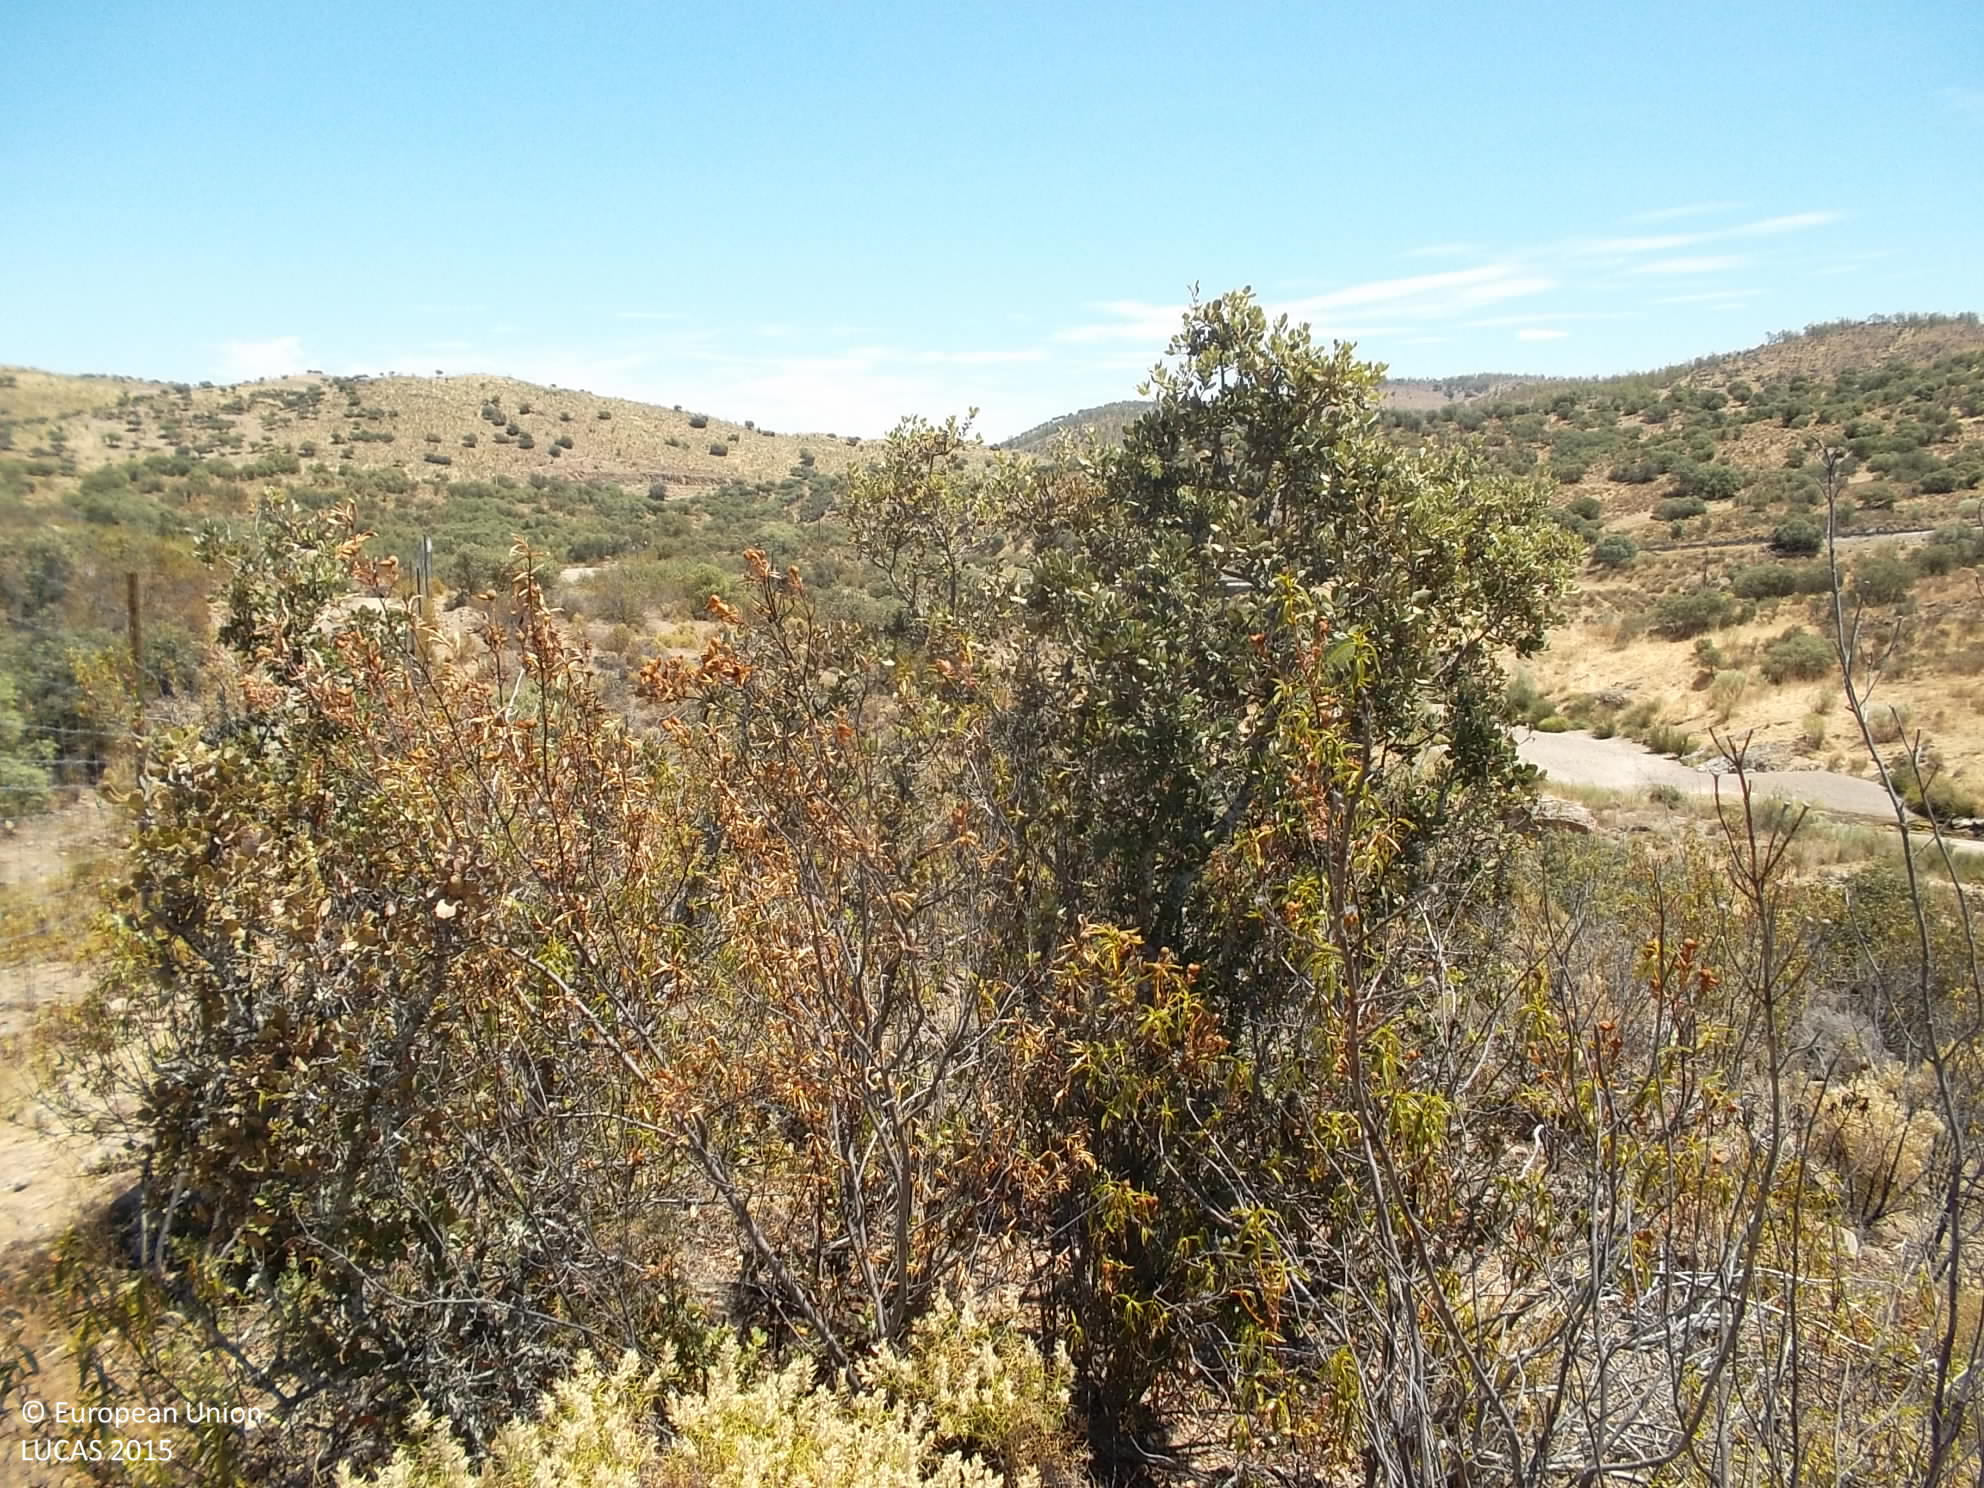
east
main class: Woodland
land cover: Broadleaved woodland
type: broadleaved evergreen forest
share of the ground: 25 - 50 %
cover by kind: shrubs 70 %, broadleaved forest trees 30 %
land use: Forestry
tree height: > 5 m
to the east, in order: Broadleaved woodland; Shrubland without tree cover; Other structural elements; Broadleaved woodland; Tracks; Fences; Shrubland without tree cover
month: July
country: ES
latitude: 38.1871
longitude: -5.6859
